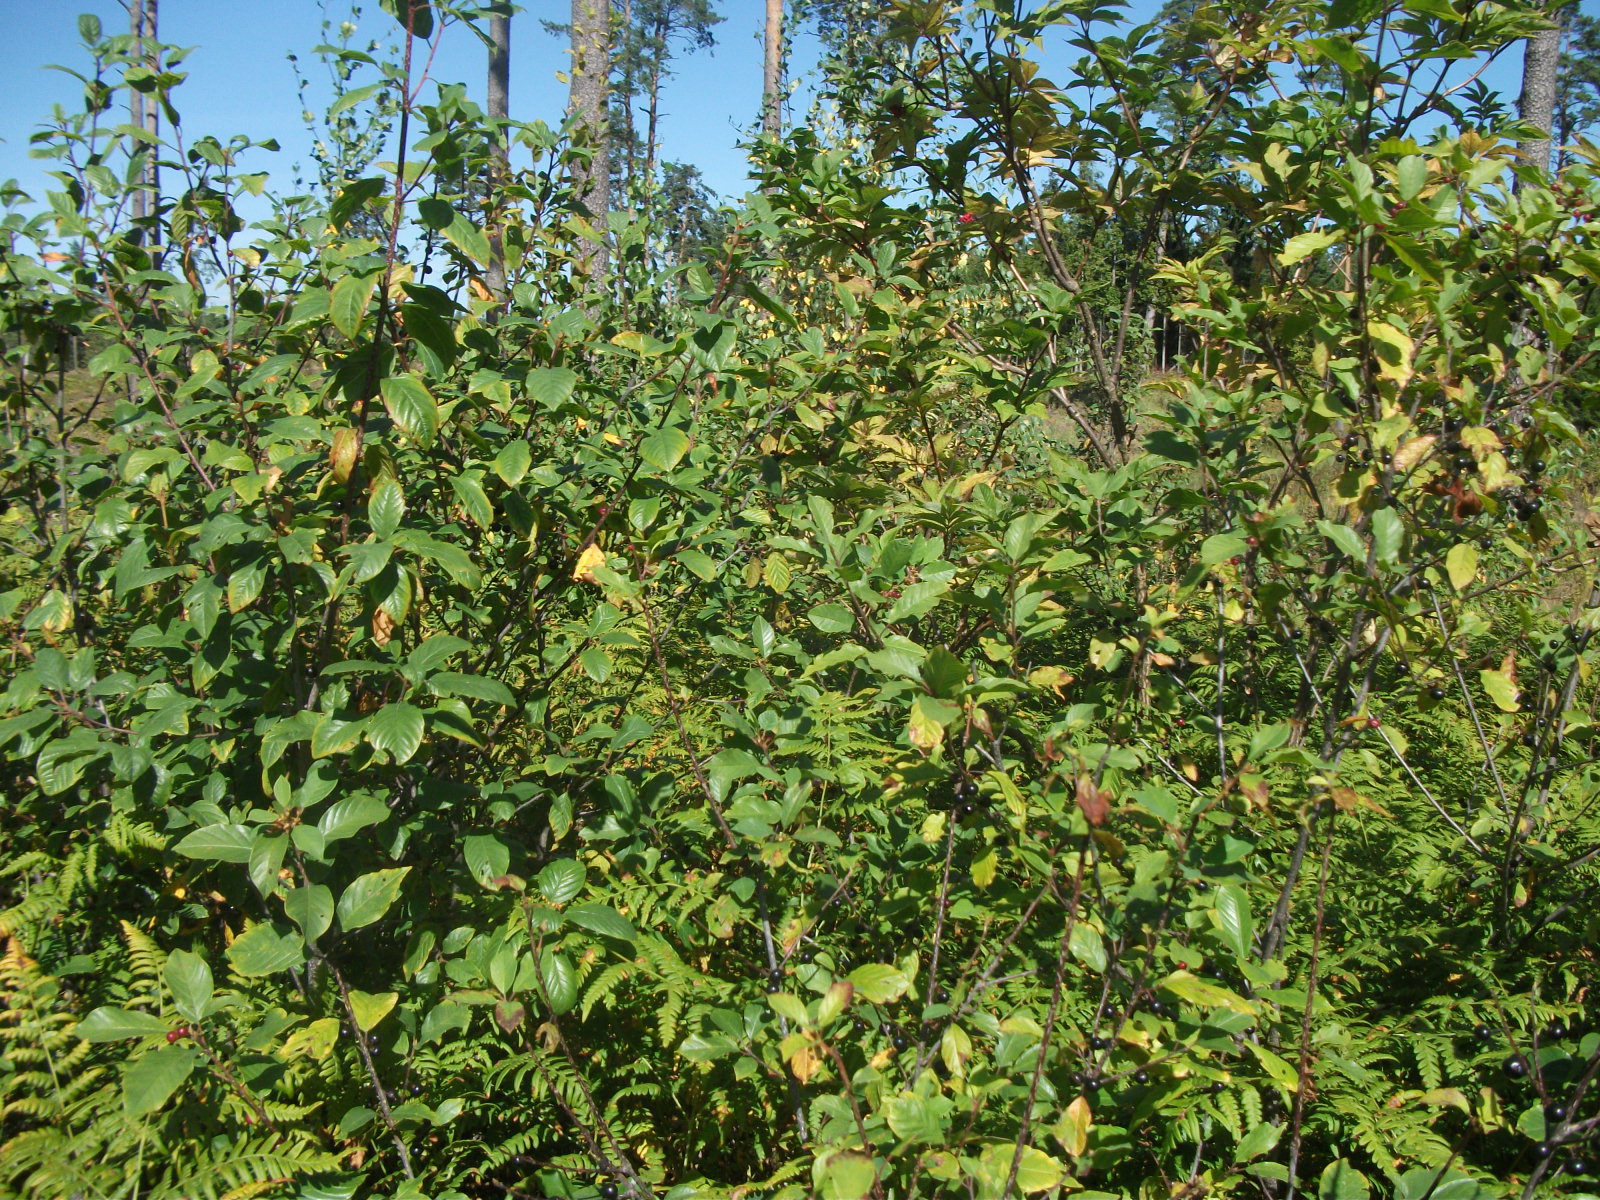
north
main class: Woodland
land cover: Broadleaved woodland
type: non-riverine alder, birch or aspen forest
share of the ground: 50 - 75 %
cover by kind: broadleaved forest trees 50 %, shrubs 30 %, herbaceous plants 15 %, coniferous forest trees 5 %
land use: Forestry
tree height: < 5 m
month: August
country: LV
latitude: 56.4888
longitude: 26.0674
